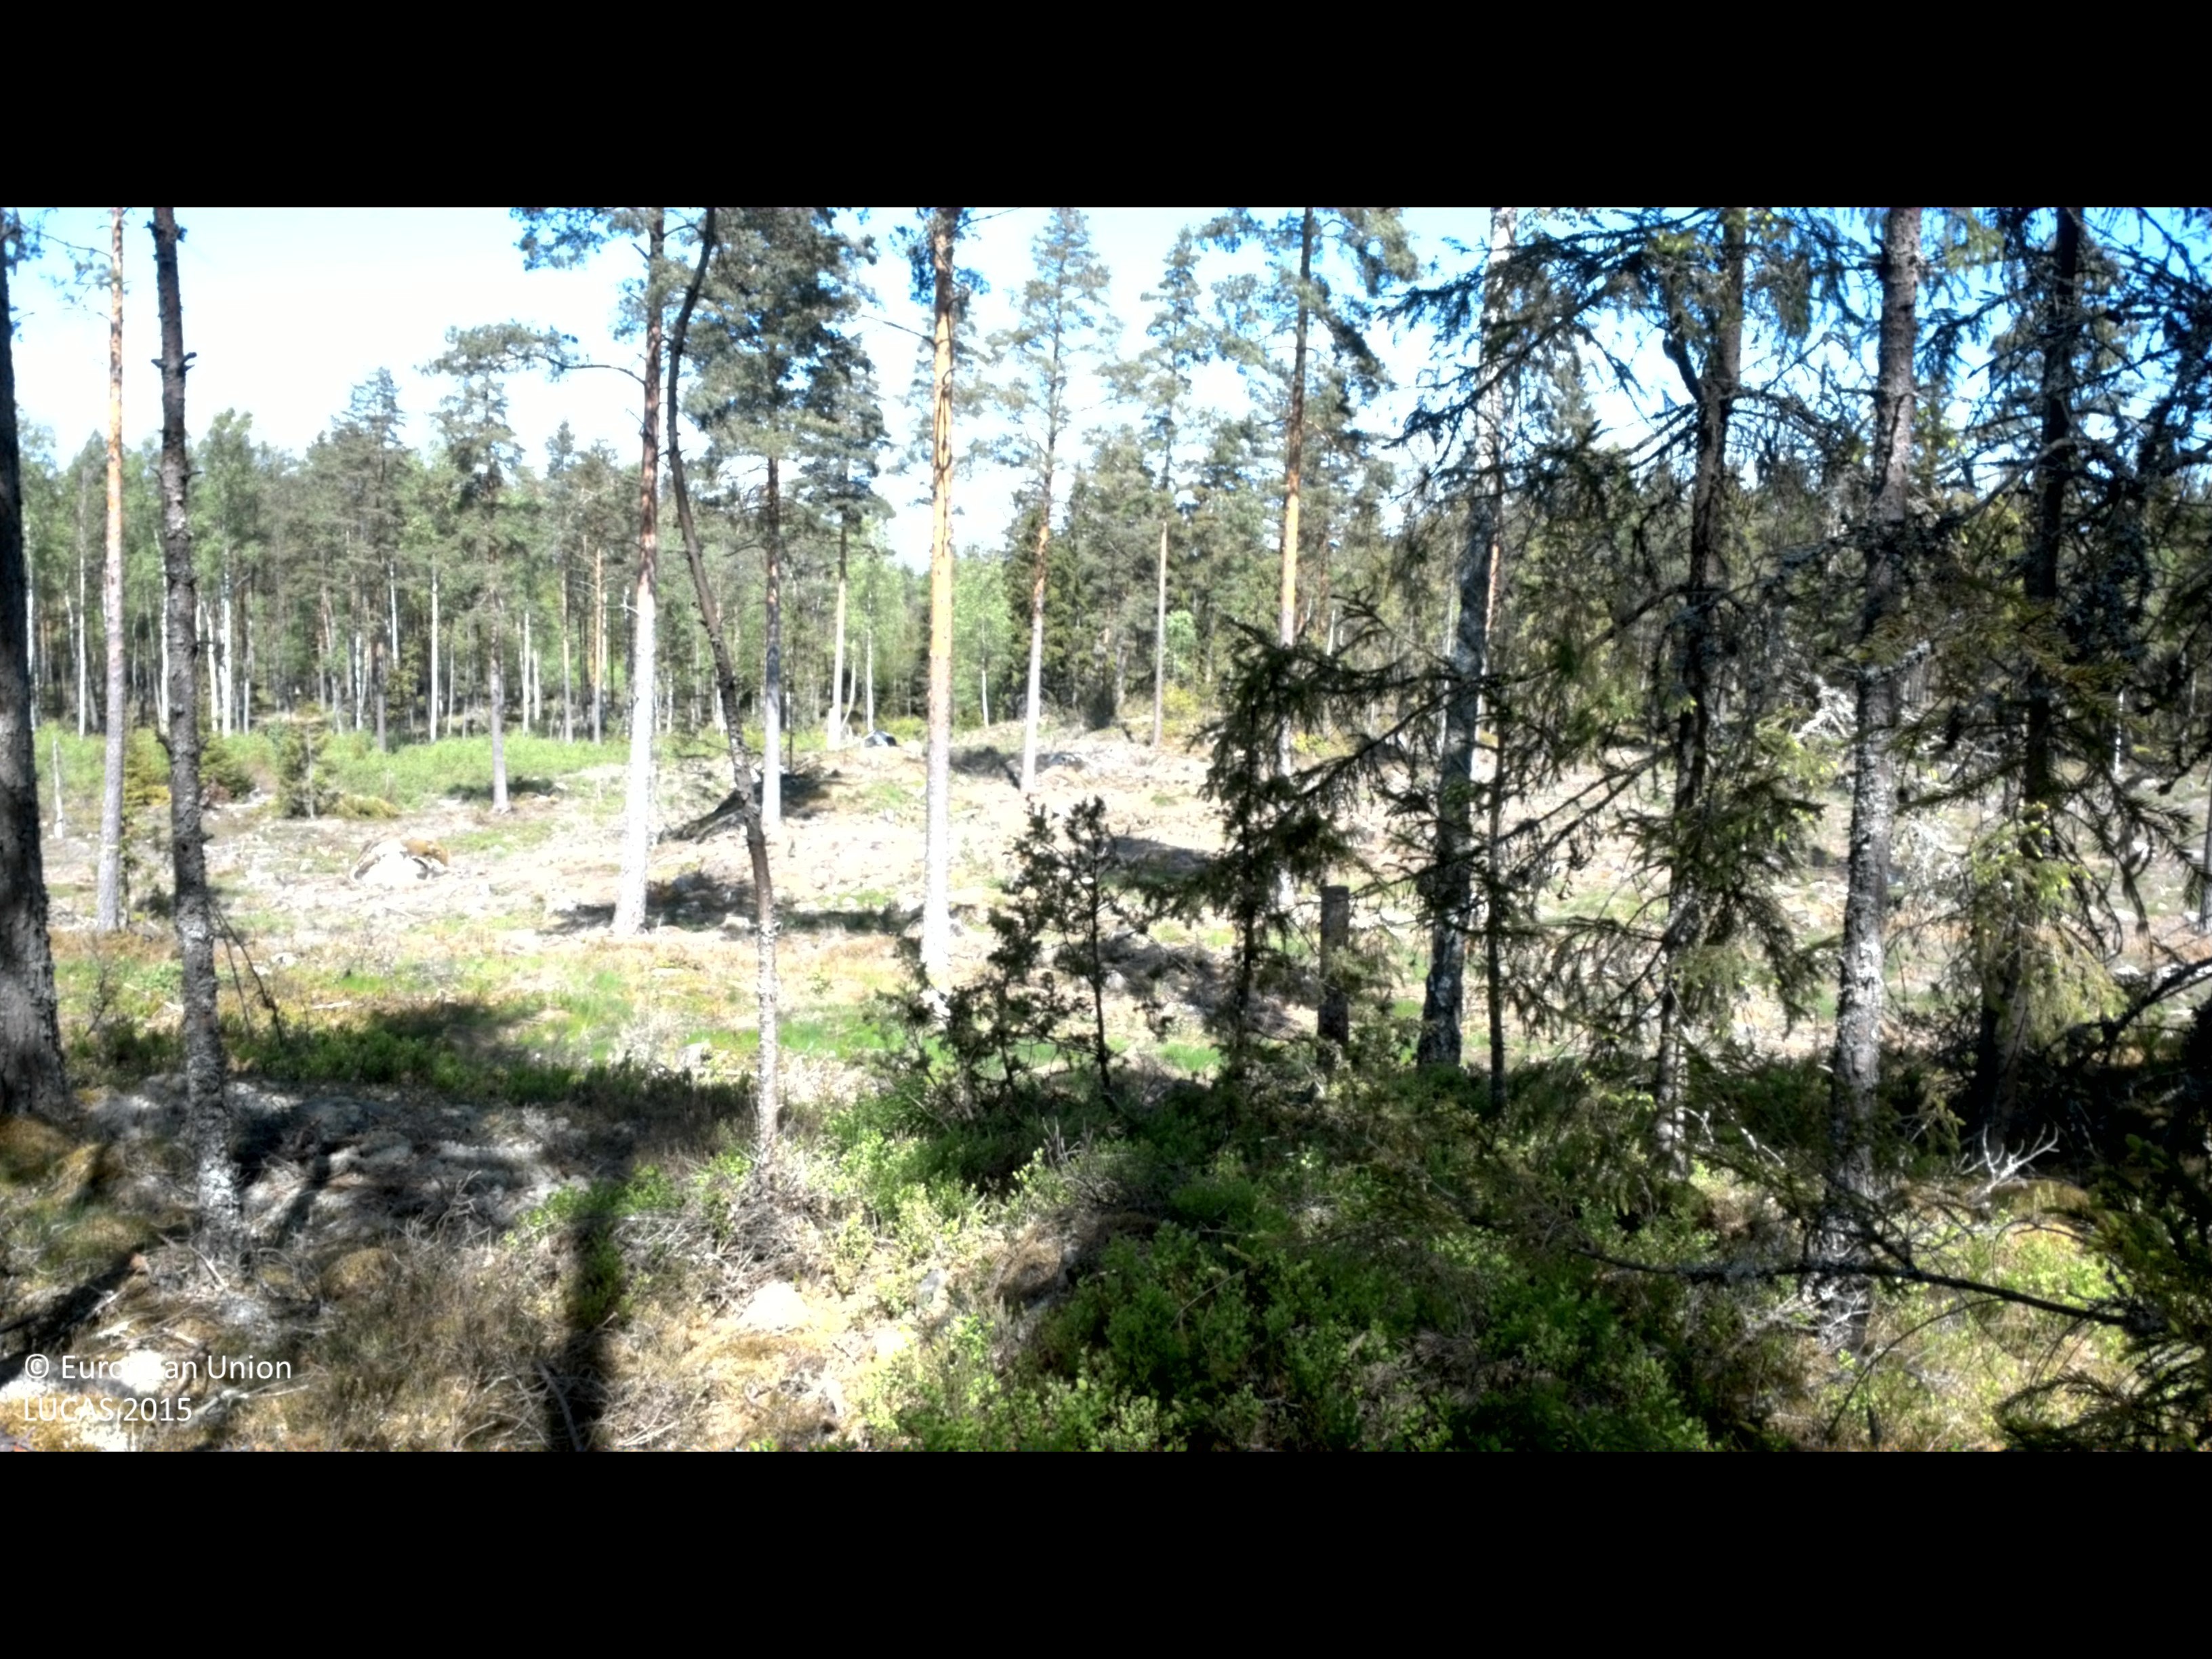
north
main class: Woodland
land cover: Pine dominated coniferous woodland
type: boreal forest
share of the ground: 50 - 75 %
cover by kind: coniferous forest trees 70 %, shrubs 20 %, herbaceous plants 10 %
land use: Forestry
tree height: > 5 m
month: May
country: SE
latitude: 57.2684
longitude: 16.1176
